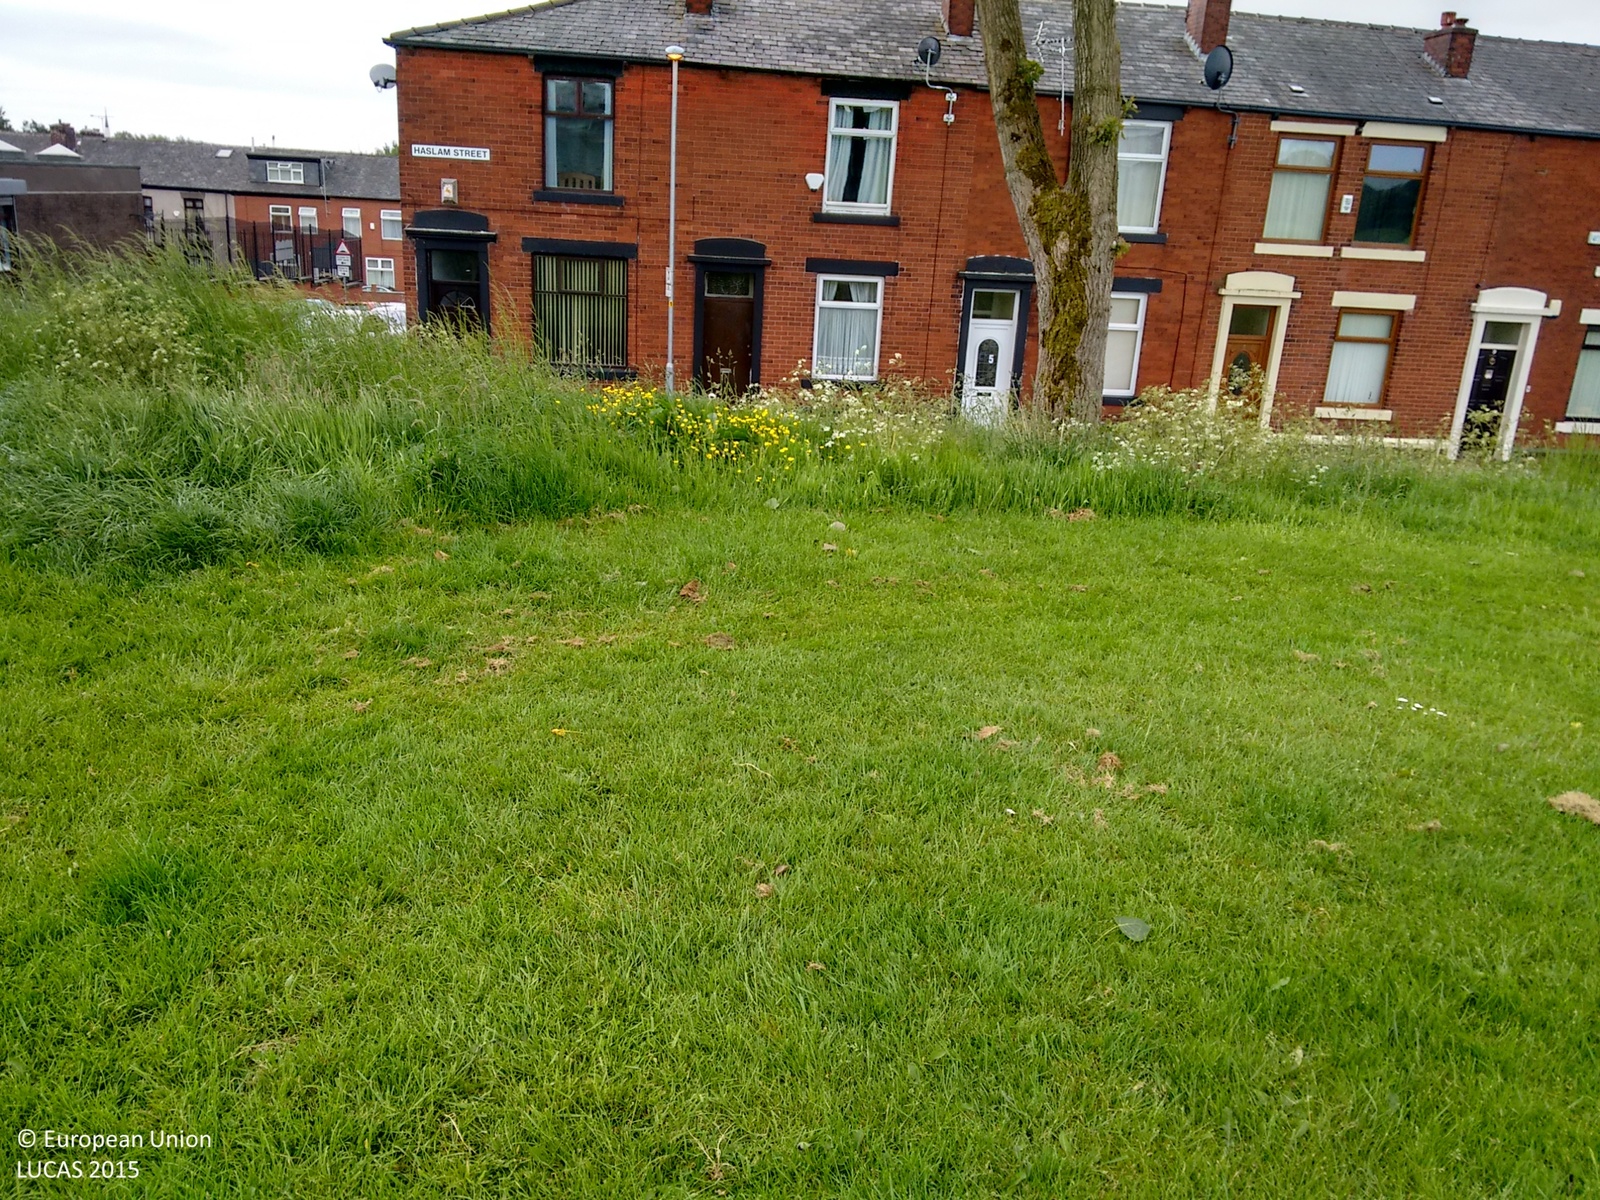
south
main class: Grassland
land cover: Grassland without tree/shrub cover
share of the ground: > 75 %
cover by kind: herbaceous plants 100 %
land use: Sport
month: June
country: GB
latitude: 53.6221
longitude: -2.1702
